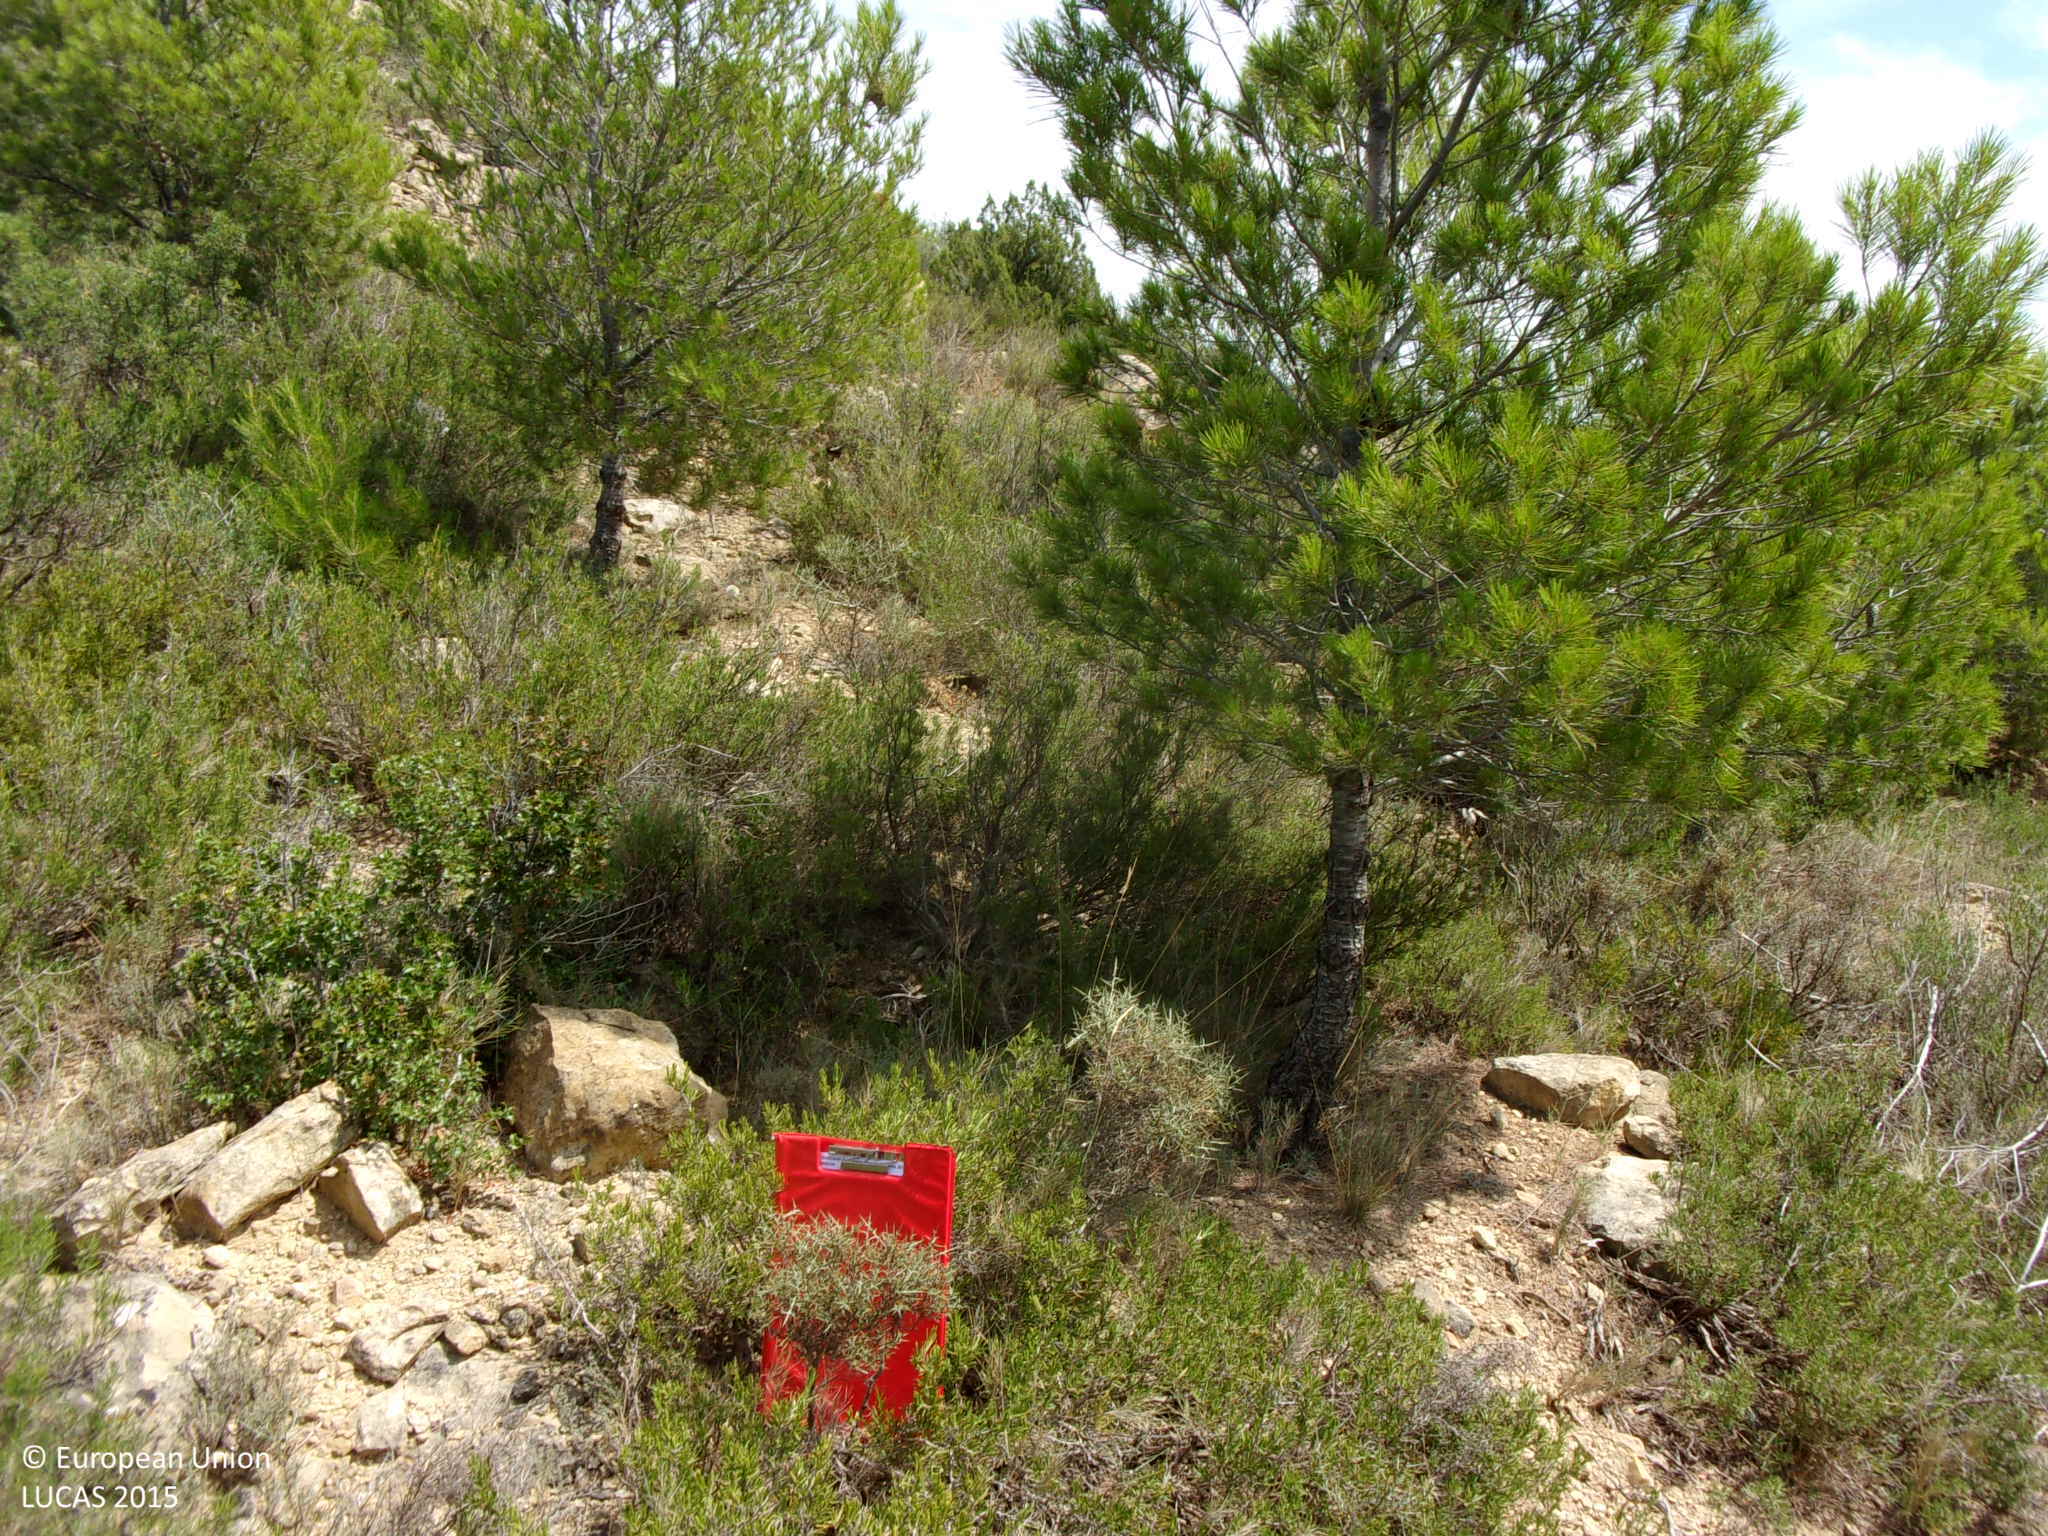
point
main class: Woodland
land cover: Pine dominated coniferous woodland
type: coniferous forest of the mediterranean region
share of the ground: 10 - 25 %
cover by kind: shrubs 50 %, coniferous forest trees 35 %, consolidated bare surface 15 %
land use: Forestry
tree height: < 5 m
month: August
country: ES
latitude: 42.1895
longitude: -1.0836
